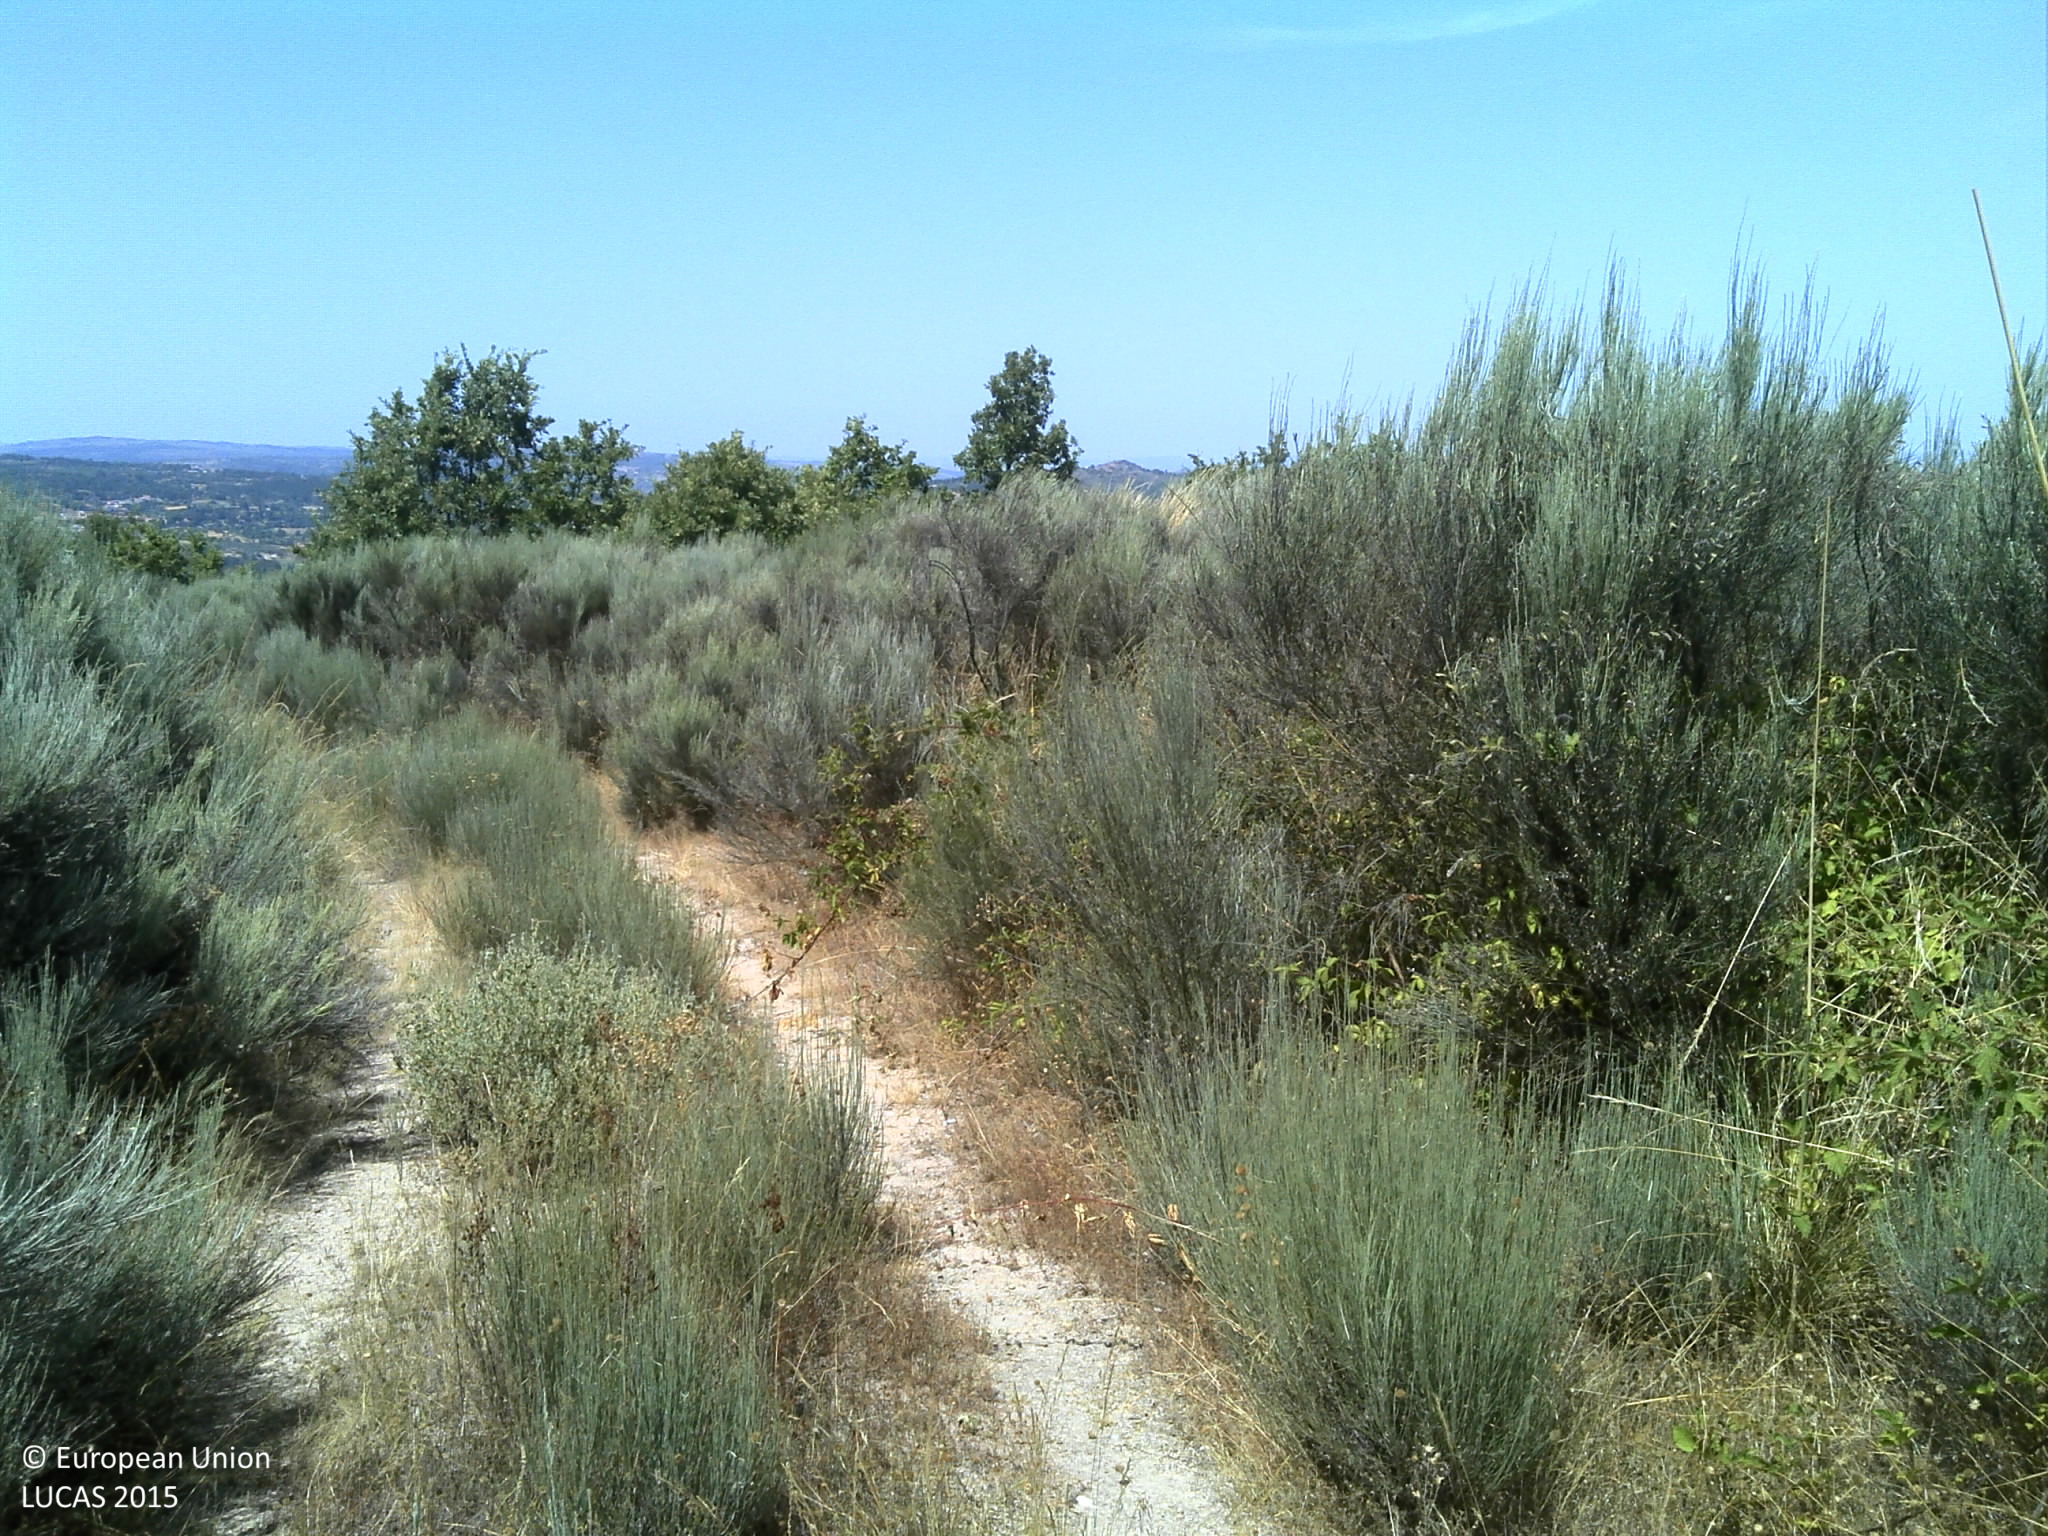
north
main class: Shrubland
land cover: Shrubland with sparse tree cover
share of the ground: > 75 %
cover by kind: shrubs 95 %, coniferous forest trees 5 %
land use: Abandoned areas
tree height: > 5 m
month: July
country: PT
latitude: 40.8310
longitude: -7.3426
